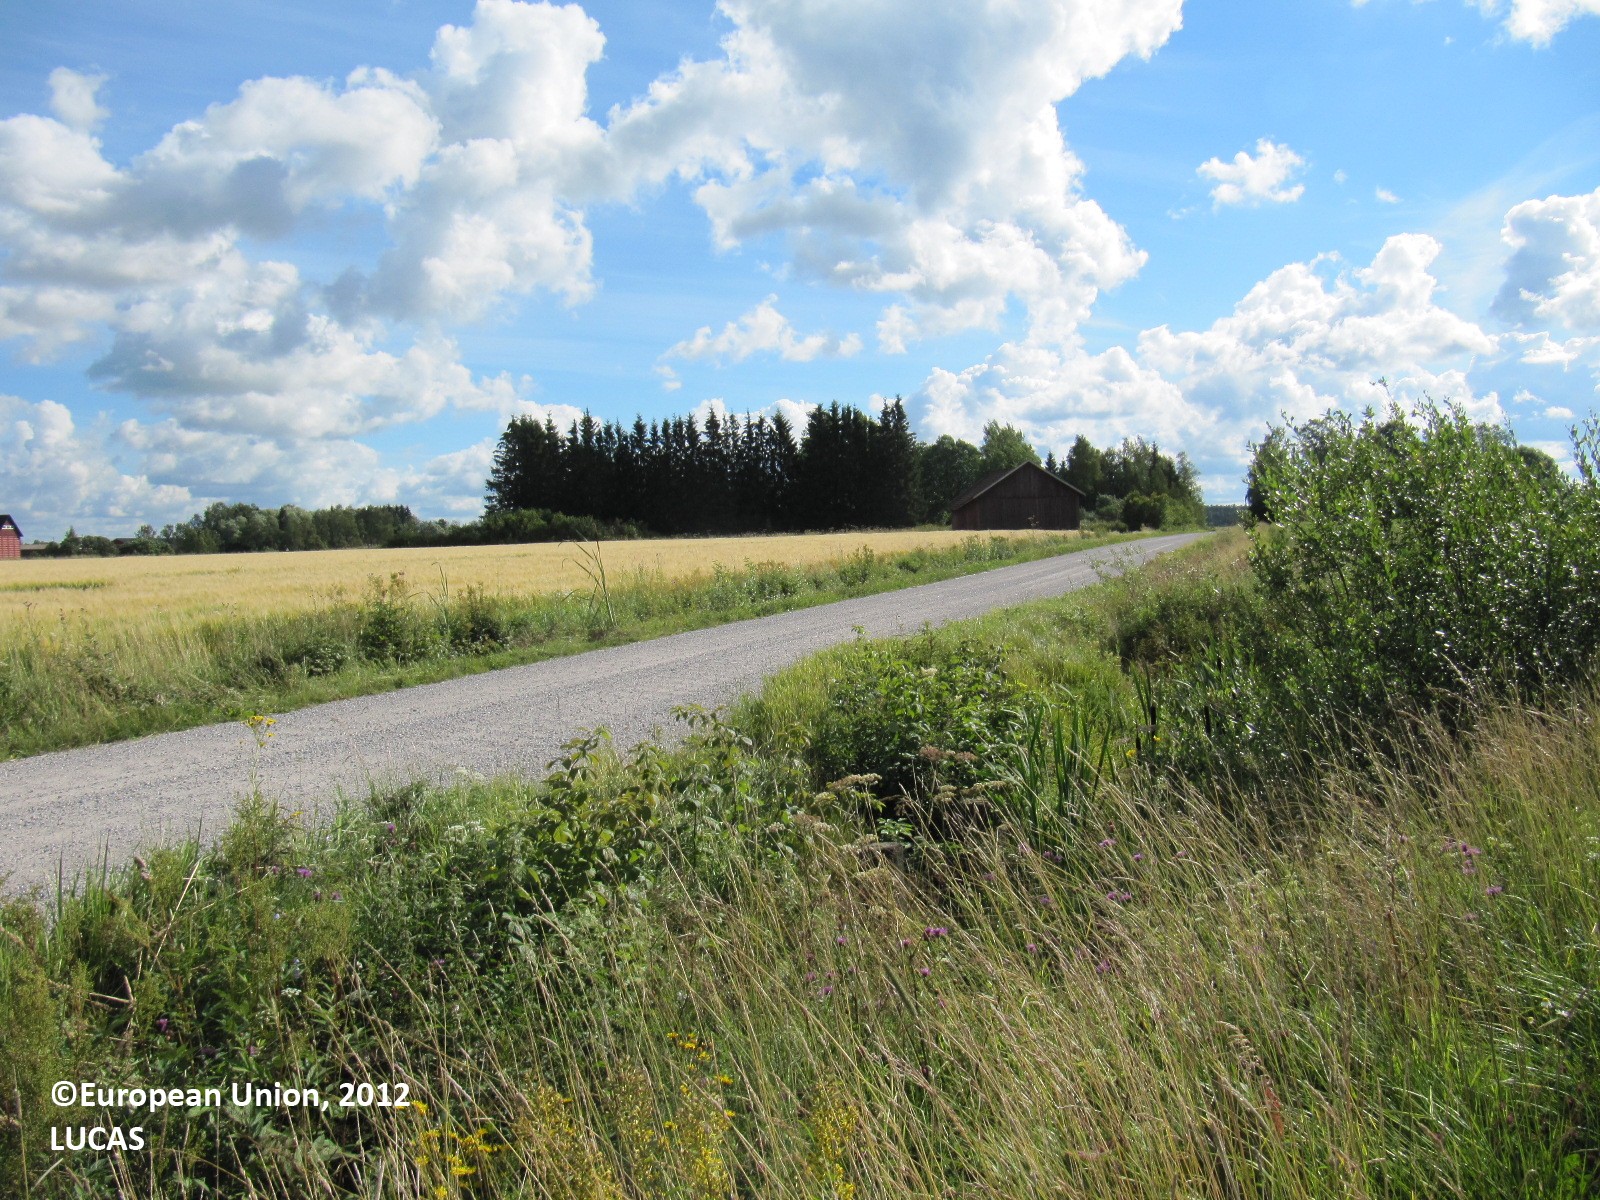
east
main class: Cropland
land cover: Common wheat
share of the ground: > 75 %
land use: Agriculture (excluding fallow land and kitchen gardens)
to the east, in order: Common wheat; Spontaneously vegetated surfaces; Common wheat
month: August
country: FI
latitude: 60.5103
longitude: 23.1748
